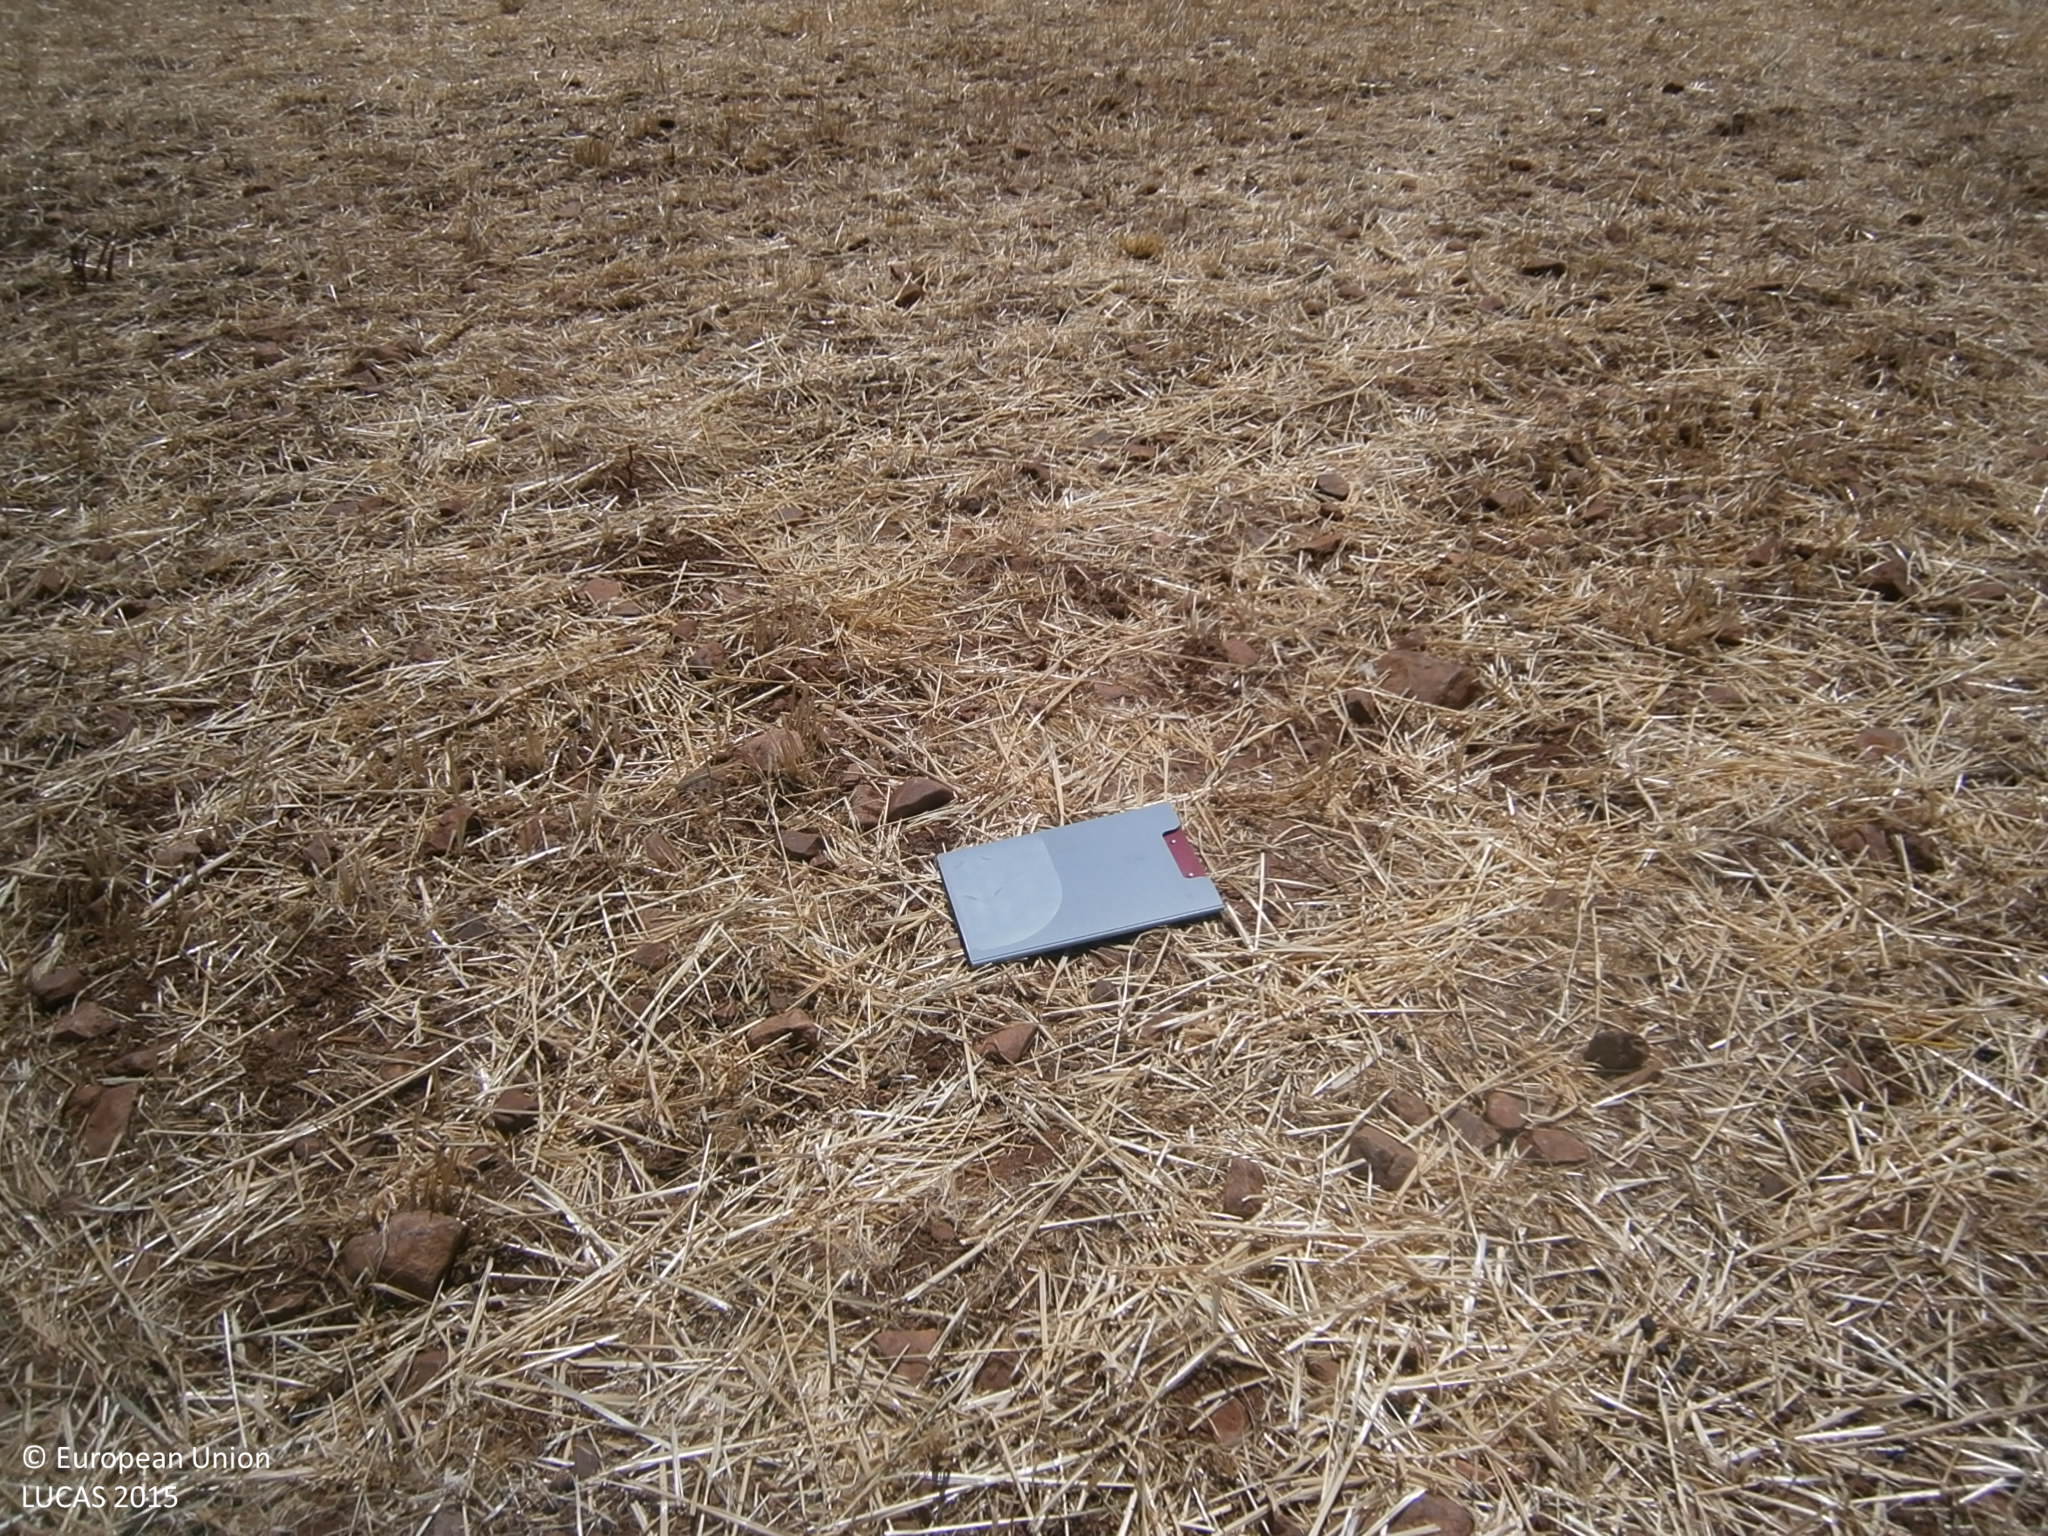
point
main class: Cropland
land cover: Temporary grasslands
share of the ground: > 75 %
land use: Agriculture (excluding fallow land and kitchen gardens)
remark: Harvested field
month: June
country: ES
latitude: 38.8129
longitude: -6.2343
